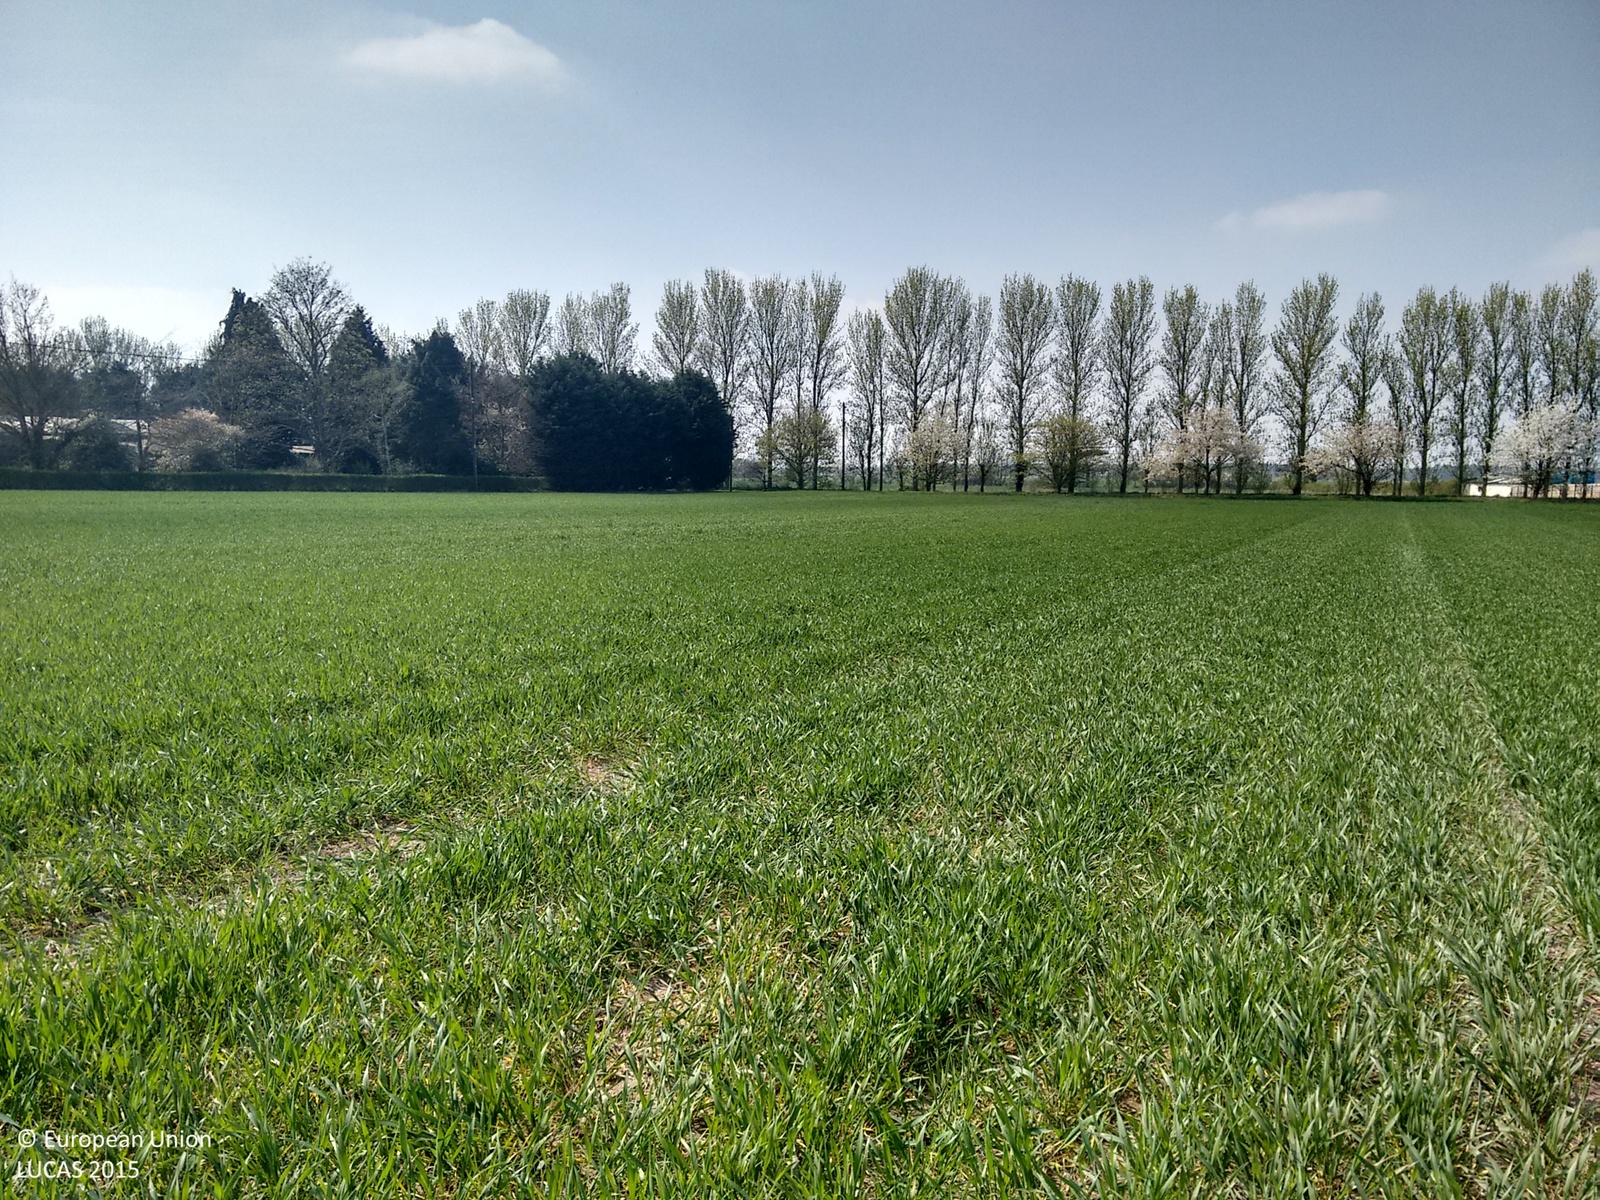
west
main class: Cropland
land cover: Common wheat
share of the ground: 50 - 75 %
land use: Agriculture (excluding fallow land and kitchen gardens)
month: April
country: GB
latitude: 53.2178
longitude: -0.6878
